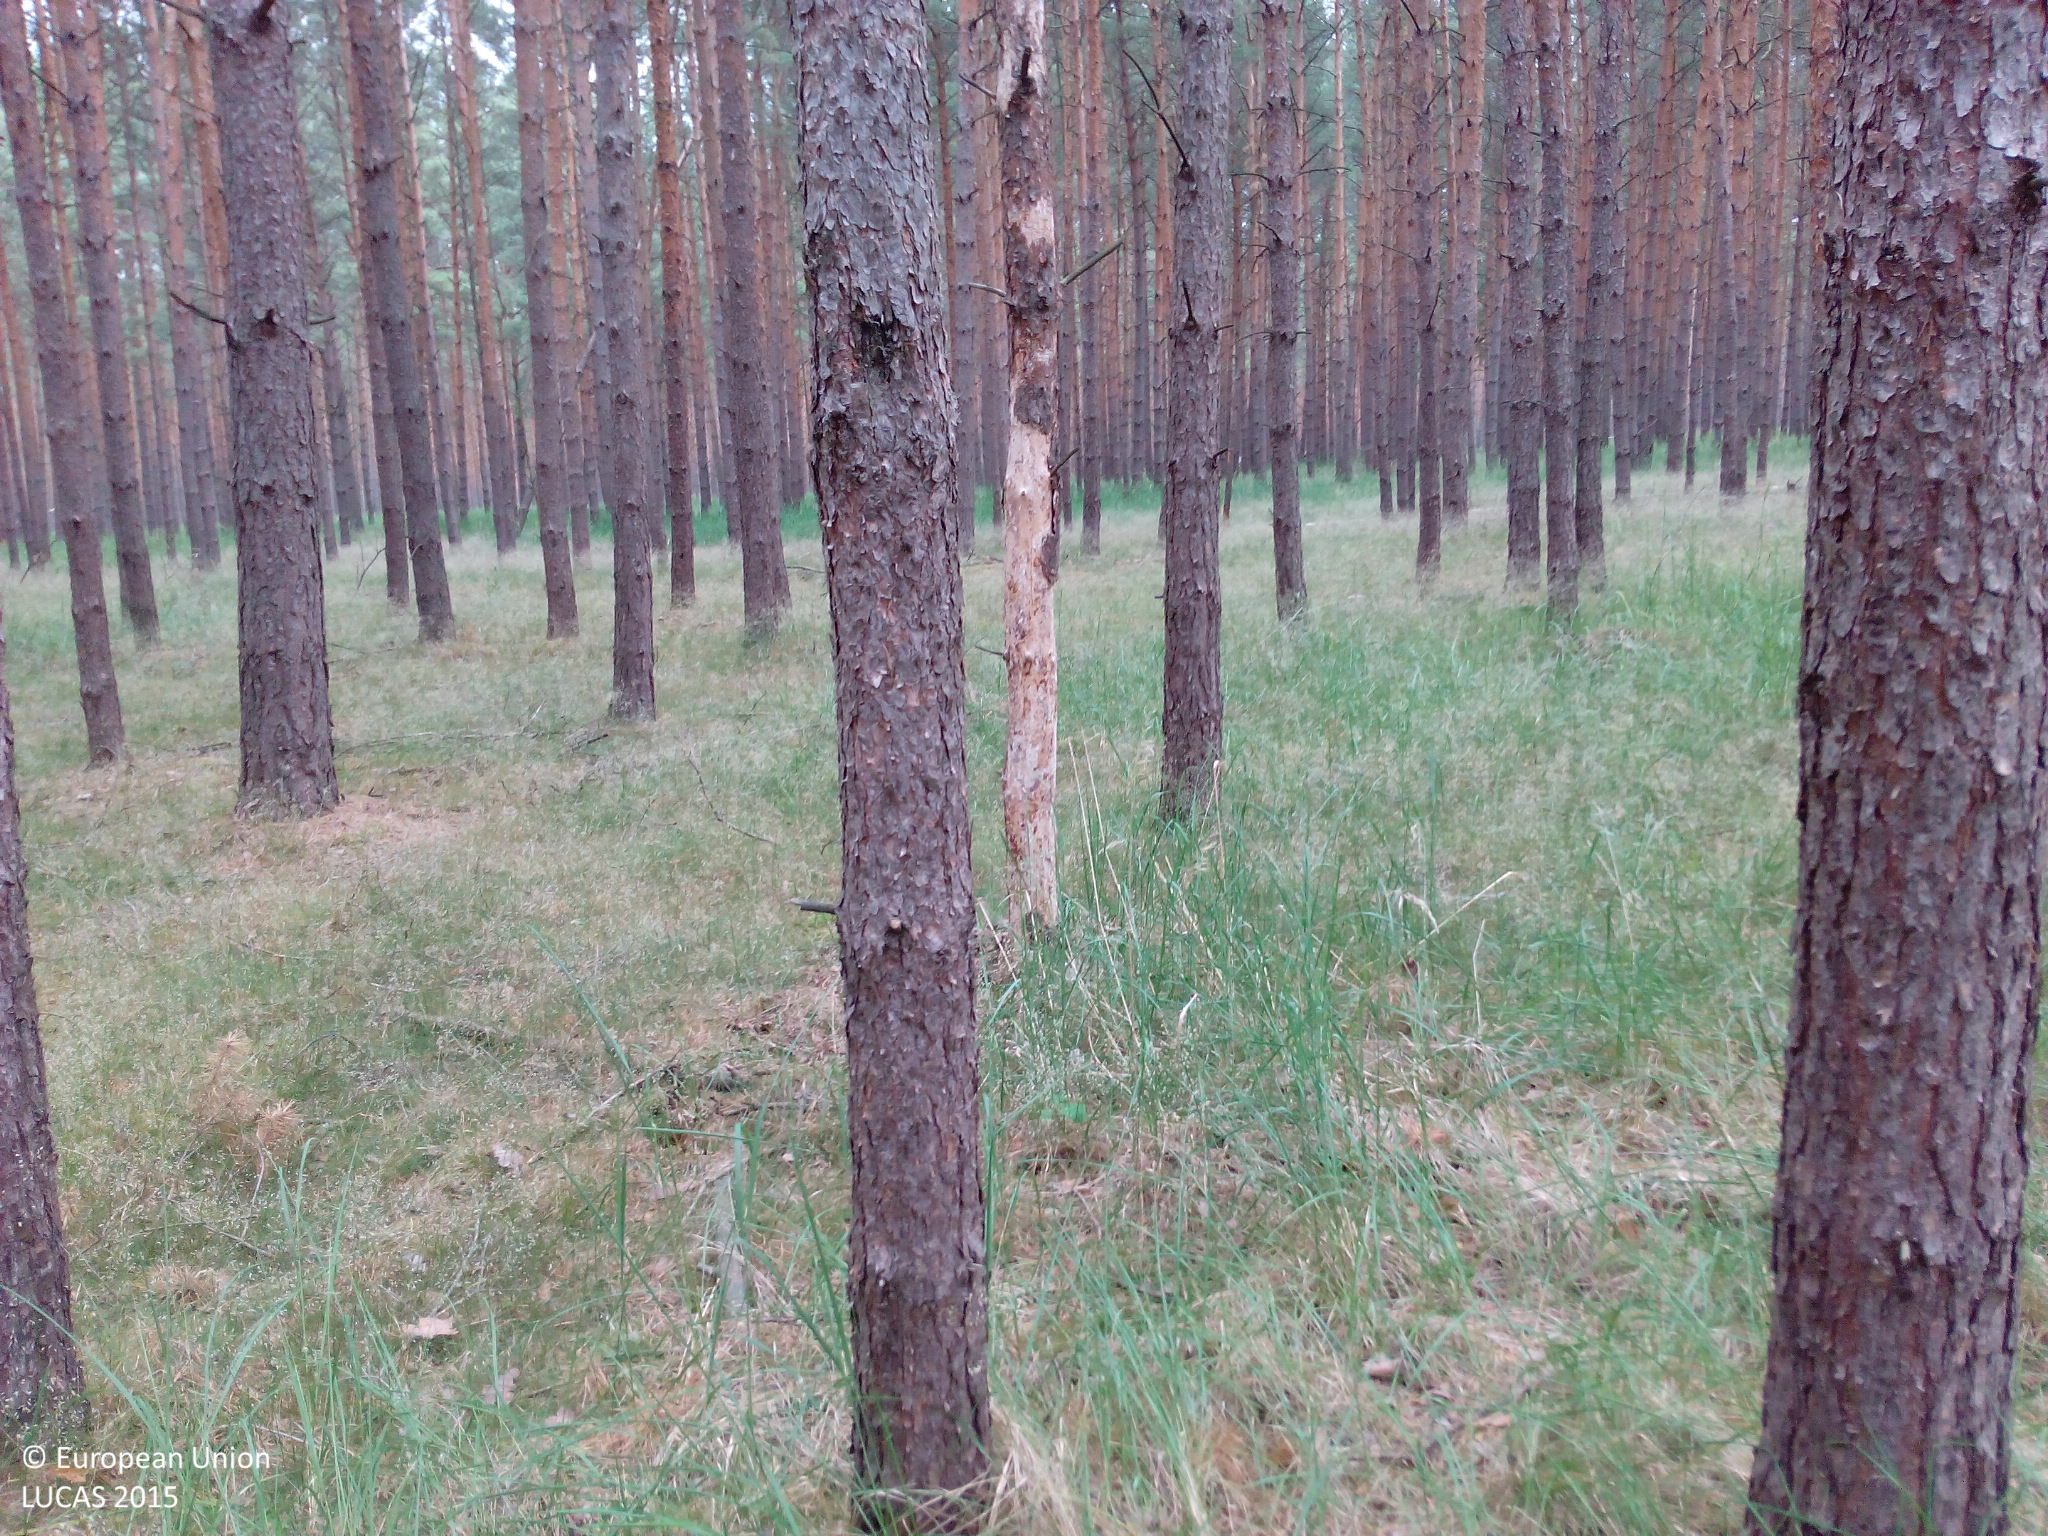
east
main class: Woodland
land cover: Pine dominated coniferous woodland
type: hemiboreal forest and nemoral coniferous forest and mixed broadleaved-coniferous forest
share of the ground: > 75 %
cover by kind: coniferous forest trees 90 %, herbaceous plants 10 %
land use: Forestry
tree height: > 5 m
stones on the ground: < 10 %
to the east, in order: Pine dominated coniferous woodland
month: June
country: DE
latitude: 52.1905
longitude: 12.4425
